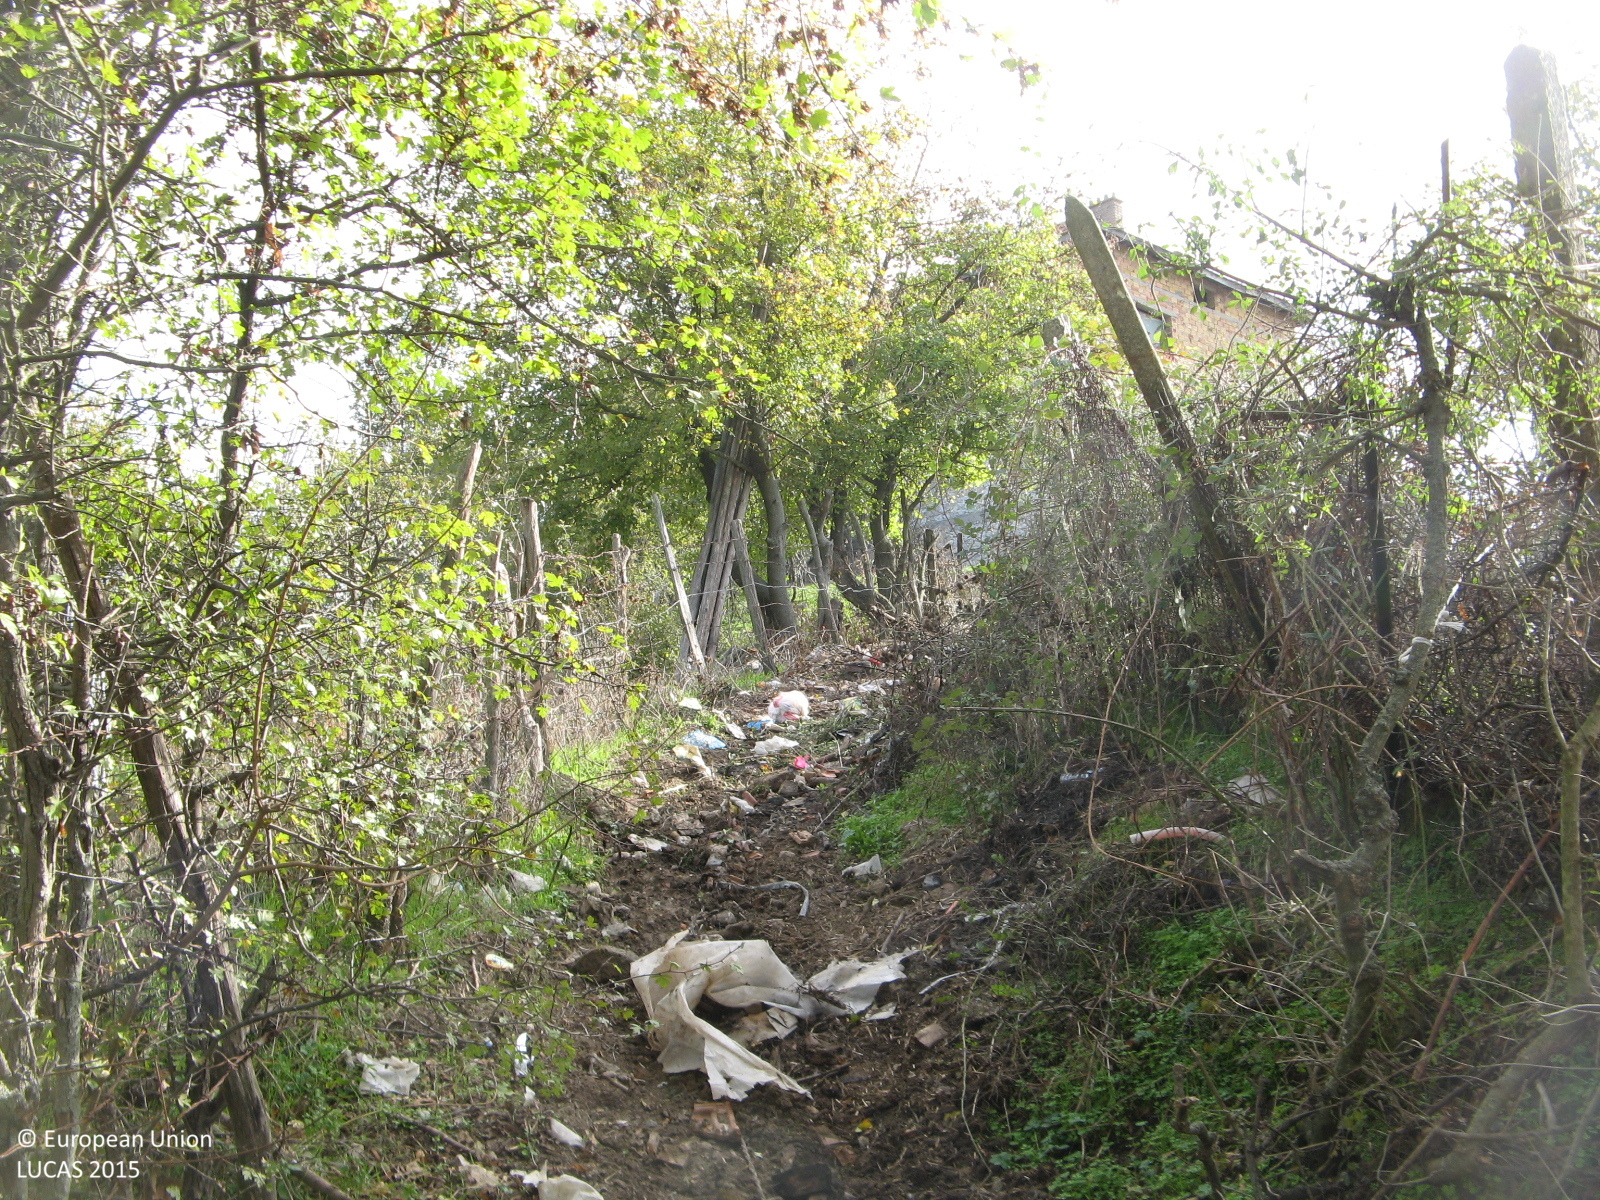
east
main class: Grassland
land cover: Grassland with sparse tree/shrub cover
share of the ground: > 75 %
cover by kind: herbaceous plants 85 %, shrubs 10 %, broadleaved forest trees 5 %
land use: Agriculture (excluding fallow land and kitchen gardens)
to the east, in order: Grassland with sparse tree/shrub cover; Artificial constructions in urban areas; Grassland without tree/shrub cover; Electric lines; Grassland without tree/shrub cover; Paved roads, cycling and walking lanes; Grassland without tree/shrub cover; Single bushes/trees; Fences; Grassland without tree/shrub cover
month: November
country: BG
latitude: 41.3954
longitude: 25.2773
